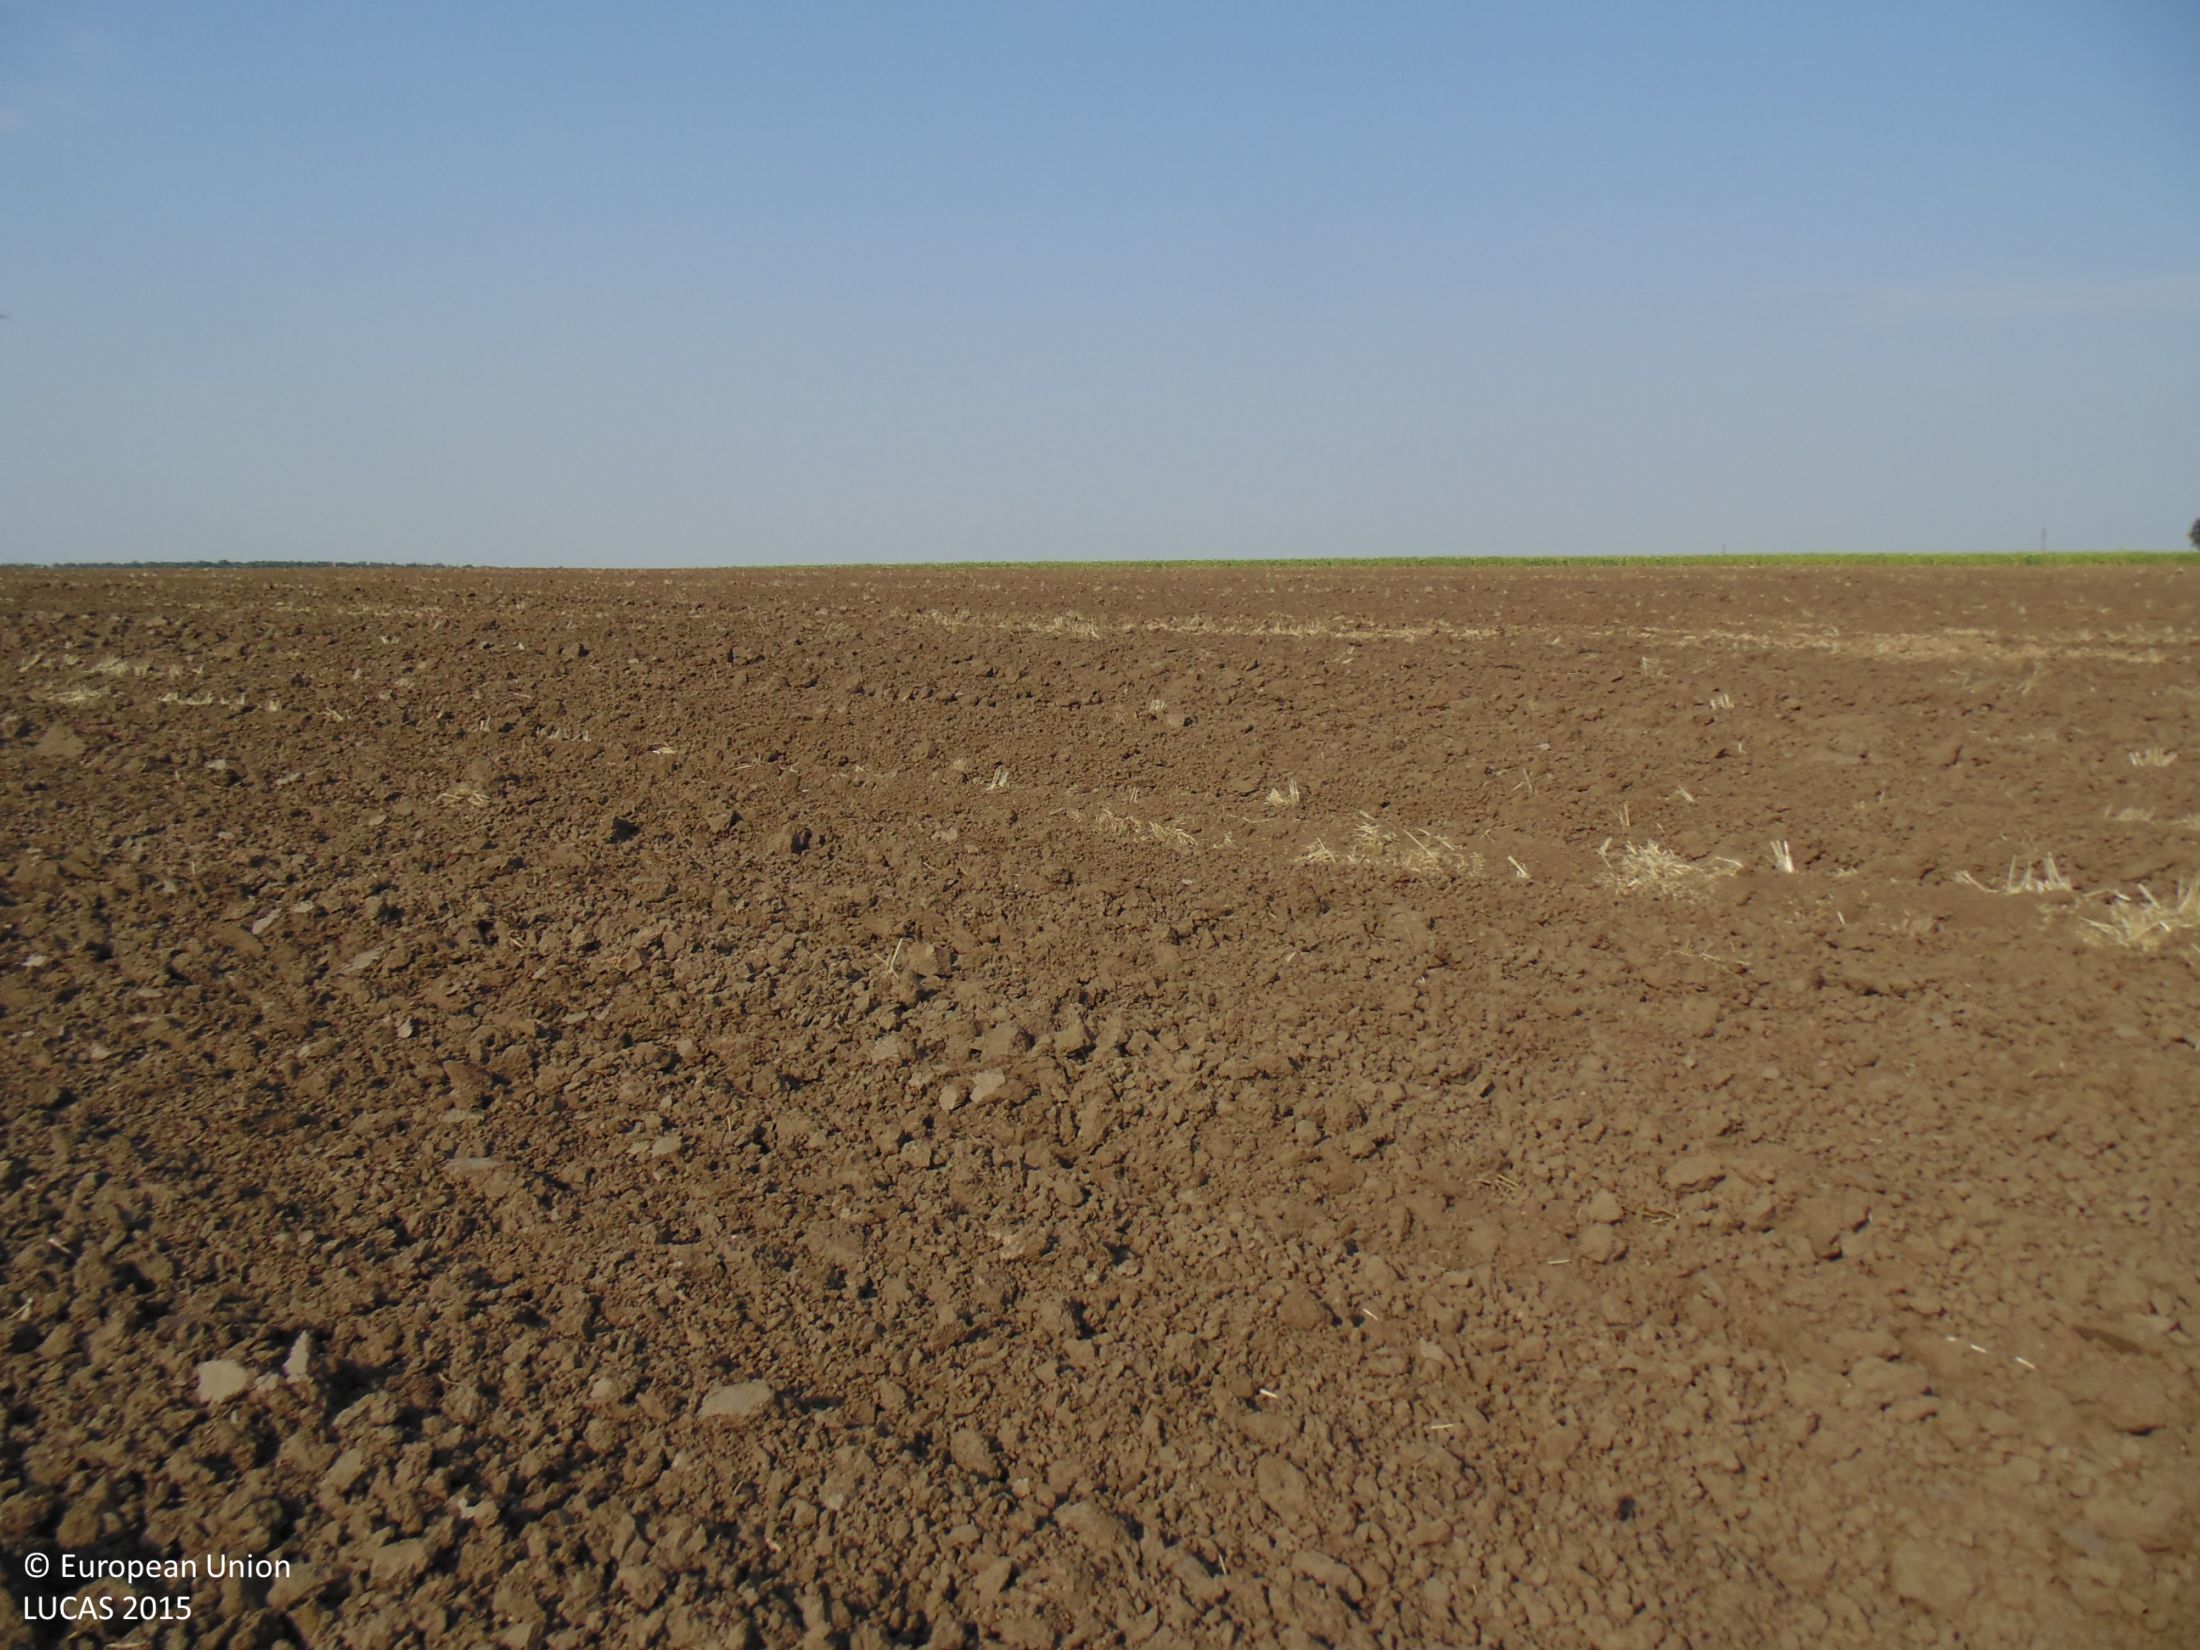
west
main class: Cropland
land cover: Common wheat
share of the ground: < 10 %
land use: Agriculture (excluding fallow land and kitchen gardens)
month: August
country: BG
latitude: 43.7168
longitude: 27.7025
